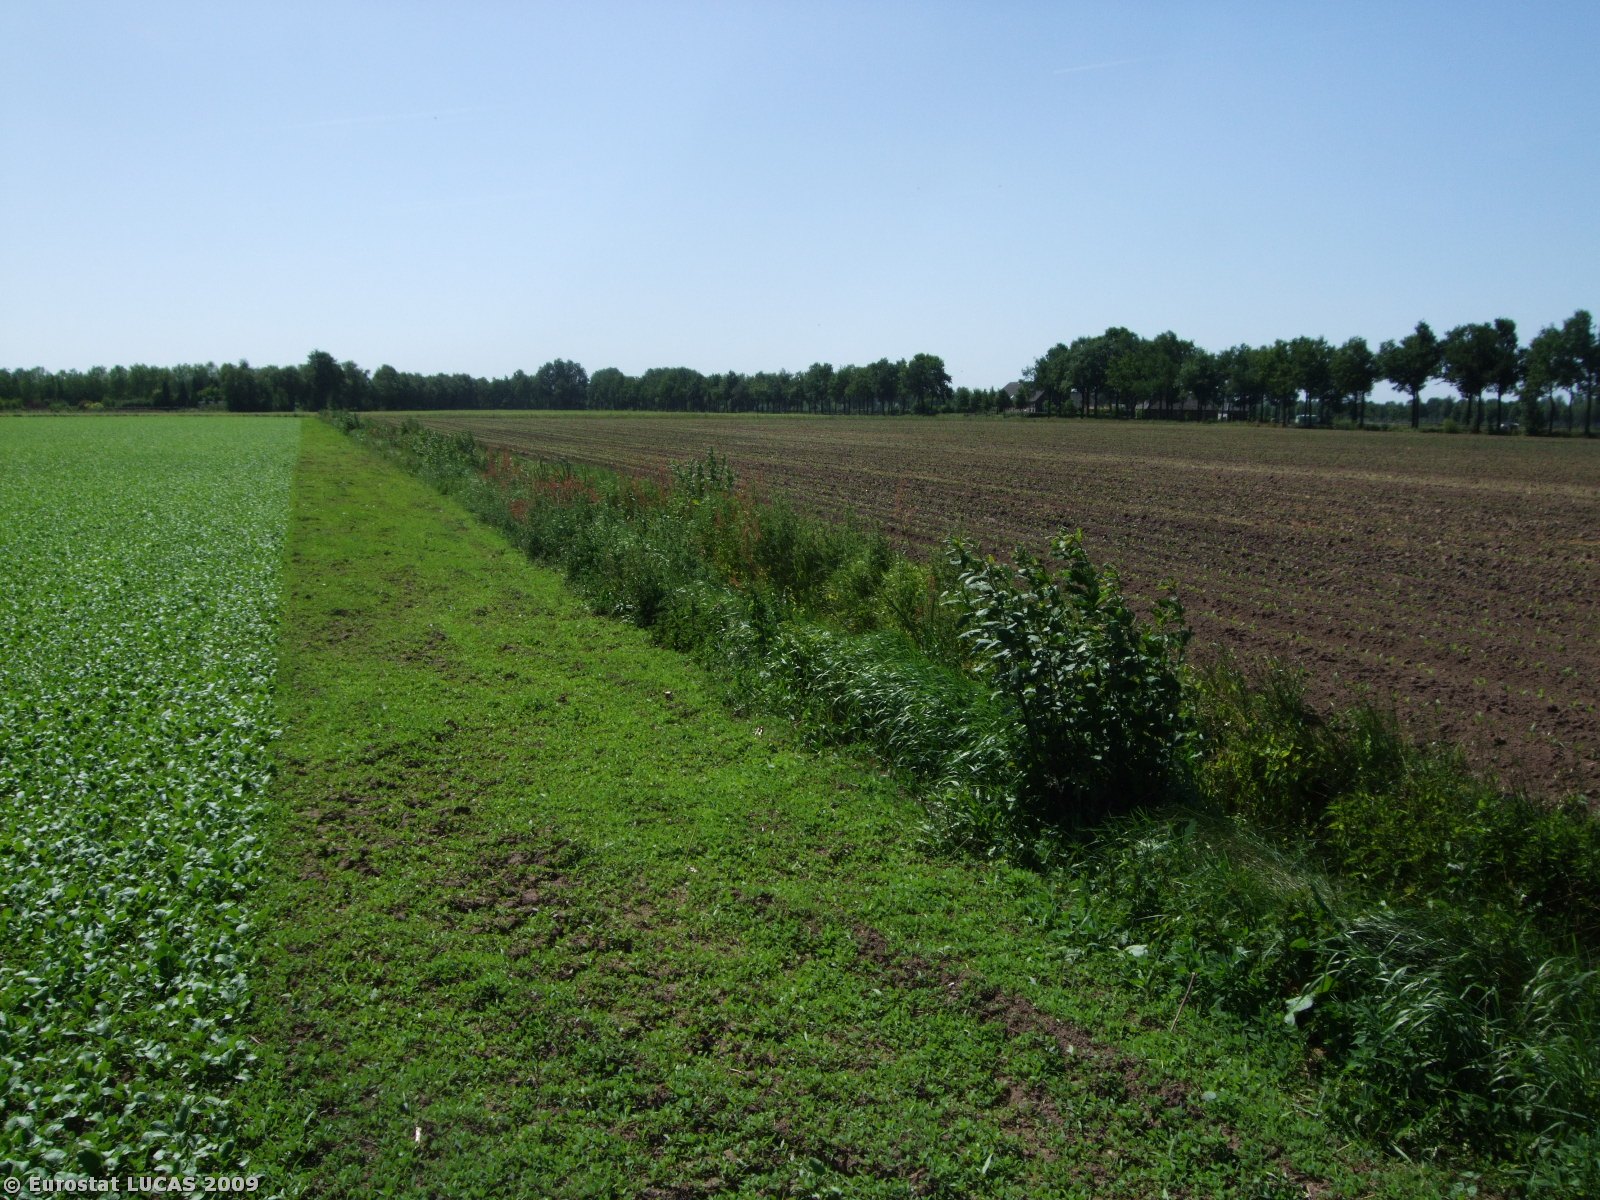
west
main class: Cropland
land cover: Other root crops
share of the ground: > 75 %
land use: Agriculture (excluding fallow land and kitchen gardens)
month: June
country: NL
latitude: 51.5882
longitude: 5.4516
